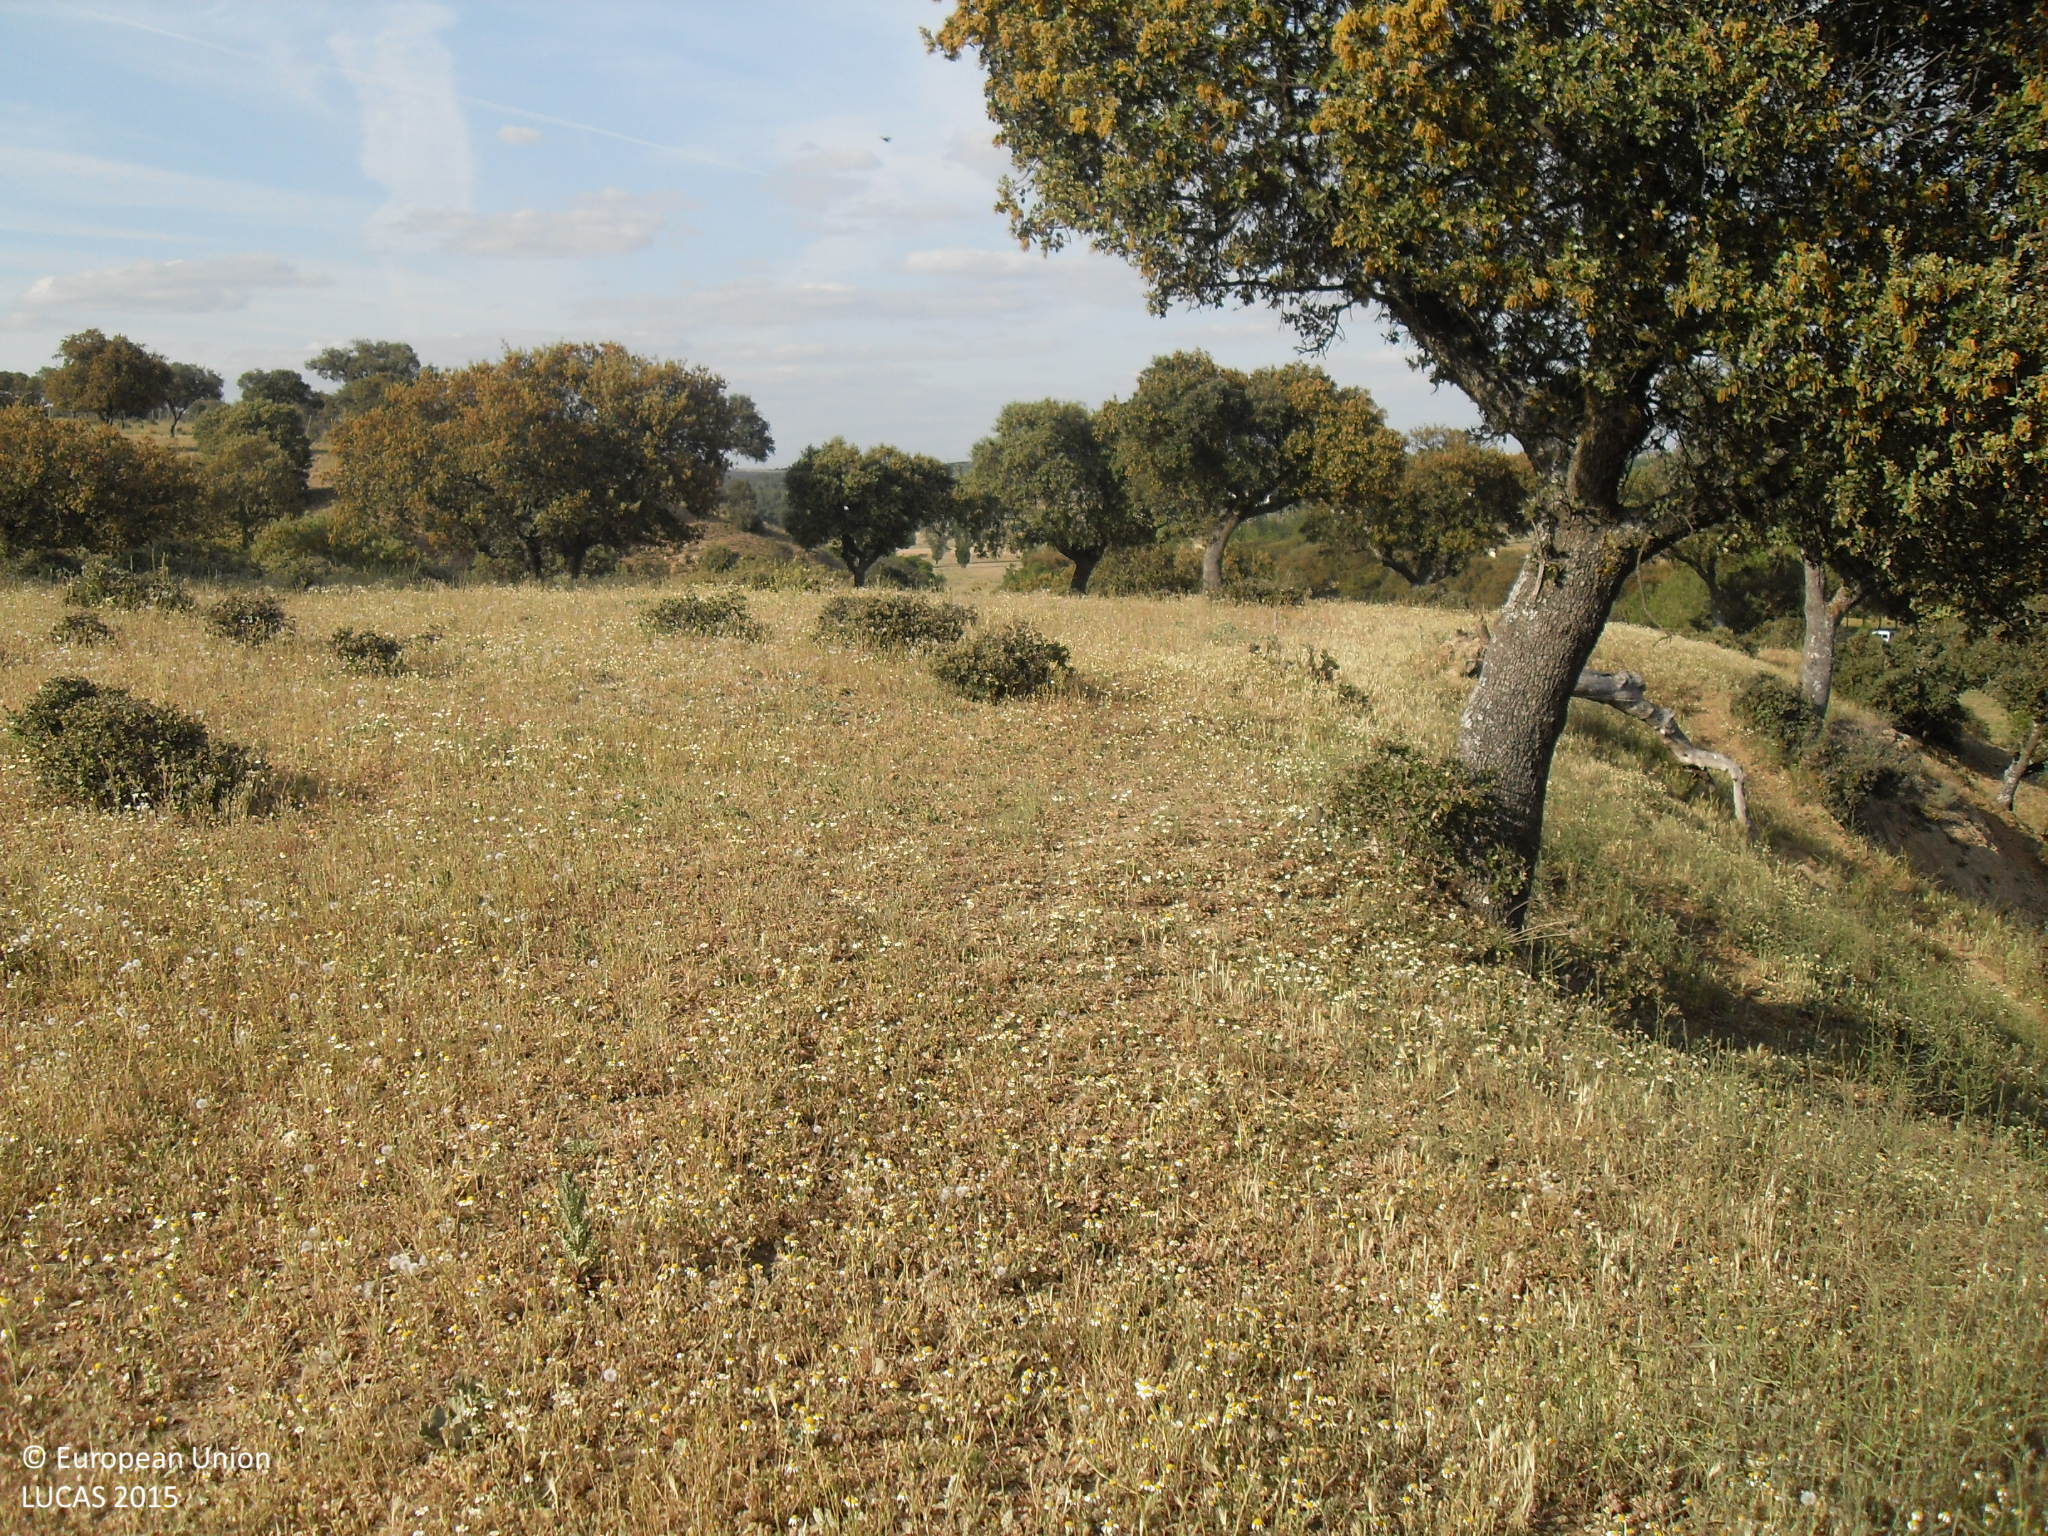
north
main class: Woodland
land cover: Broadleaved woodland
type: broadleaved evergreen forest
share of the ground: 10 - 25 %
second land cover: Grassland without tree/shrub cover
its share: > 75 %
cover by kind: herbaceous plants 80 %, broadleaved forest trees 20 %
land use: Forestry
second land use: Agriculture (excluding fallow land and kitchen gardens)
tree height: < 5 m
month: May
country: ES
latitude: 40.9927
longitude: -5.7344
